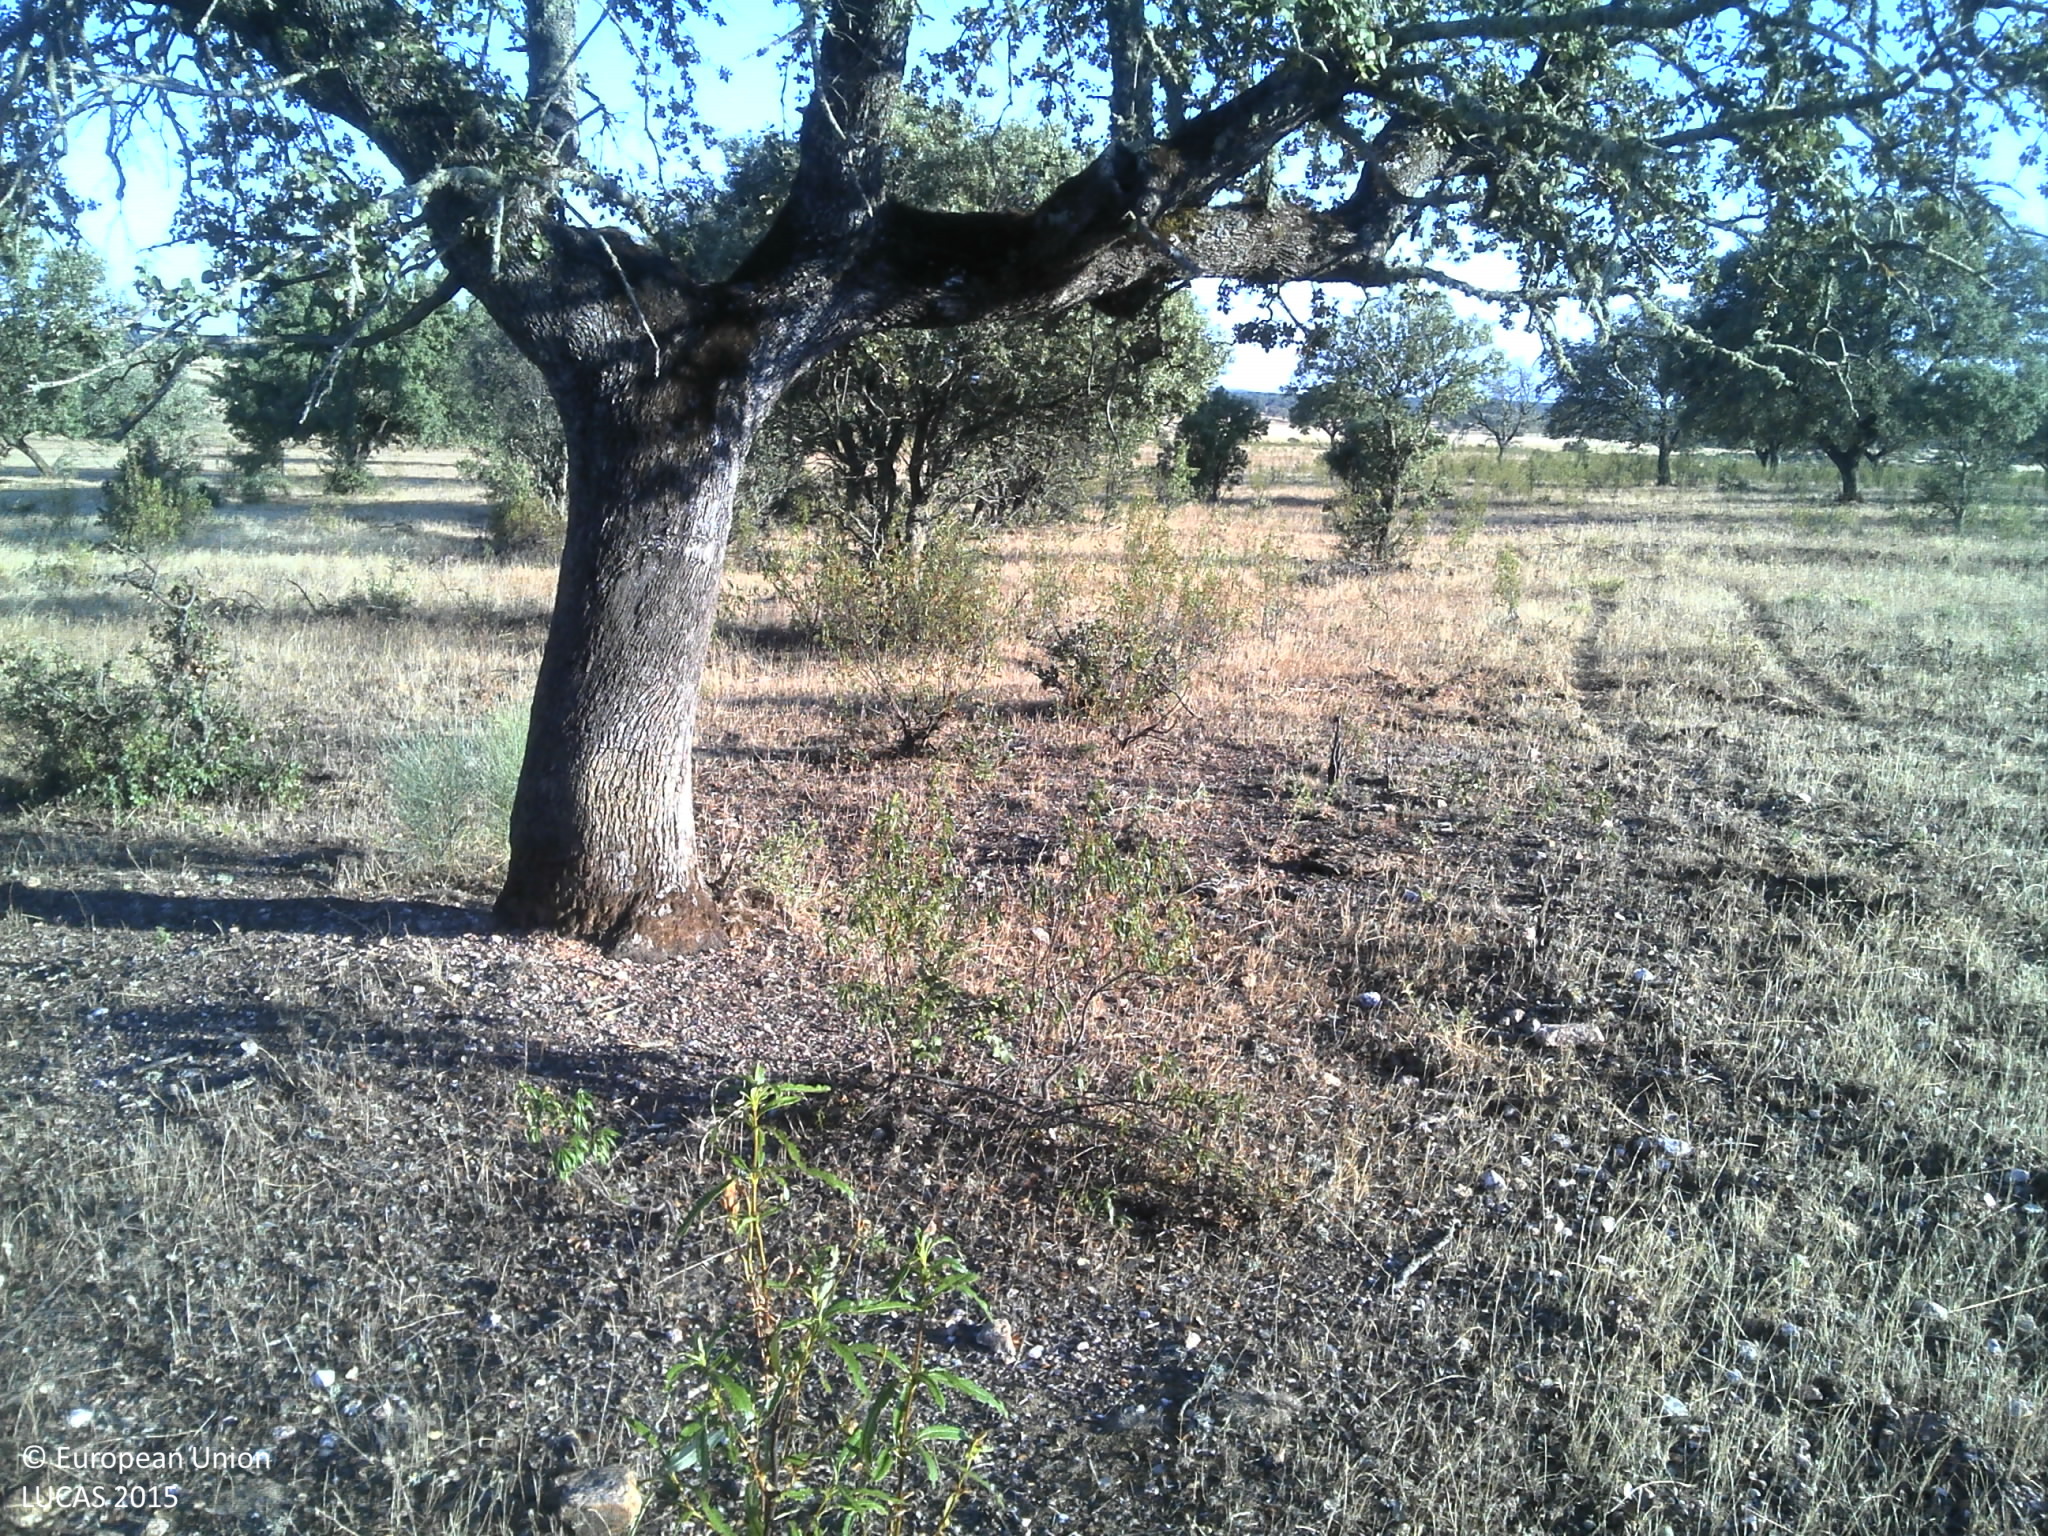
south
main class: Grassland
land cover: Grassland with sparse tree/shrub cover
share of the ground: 25 - 50 %
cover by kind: unconsolidated bare surface 45 %, herbaceous plants 40 %, broadleaved forest trees 5 %, shrubs 5 %
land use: Agriculture (excluding fallow land and kitchen gardens)
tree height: > 5 m
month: June
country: PT
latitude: 39.9388
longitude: -7.0719
